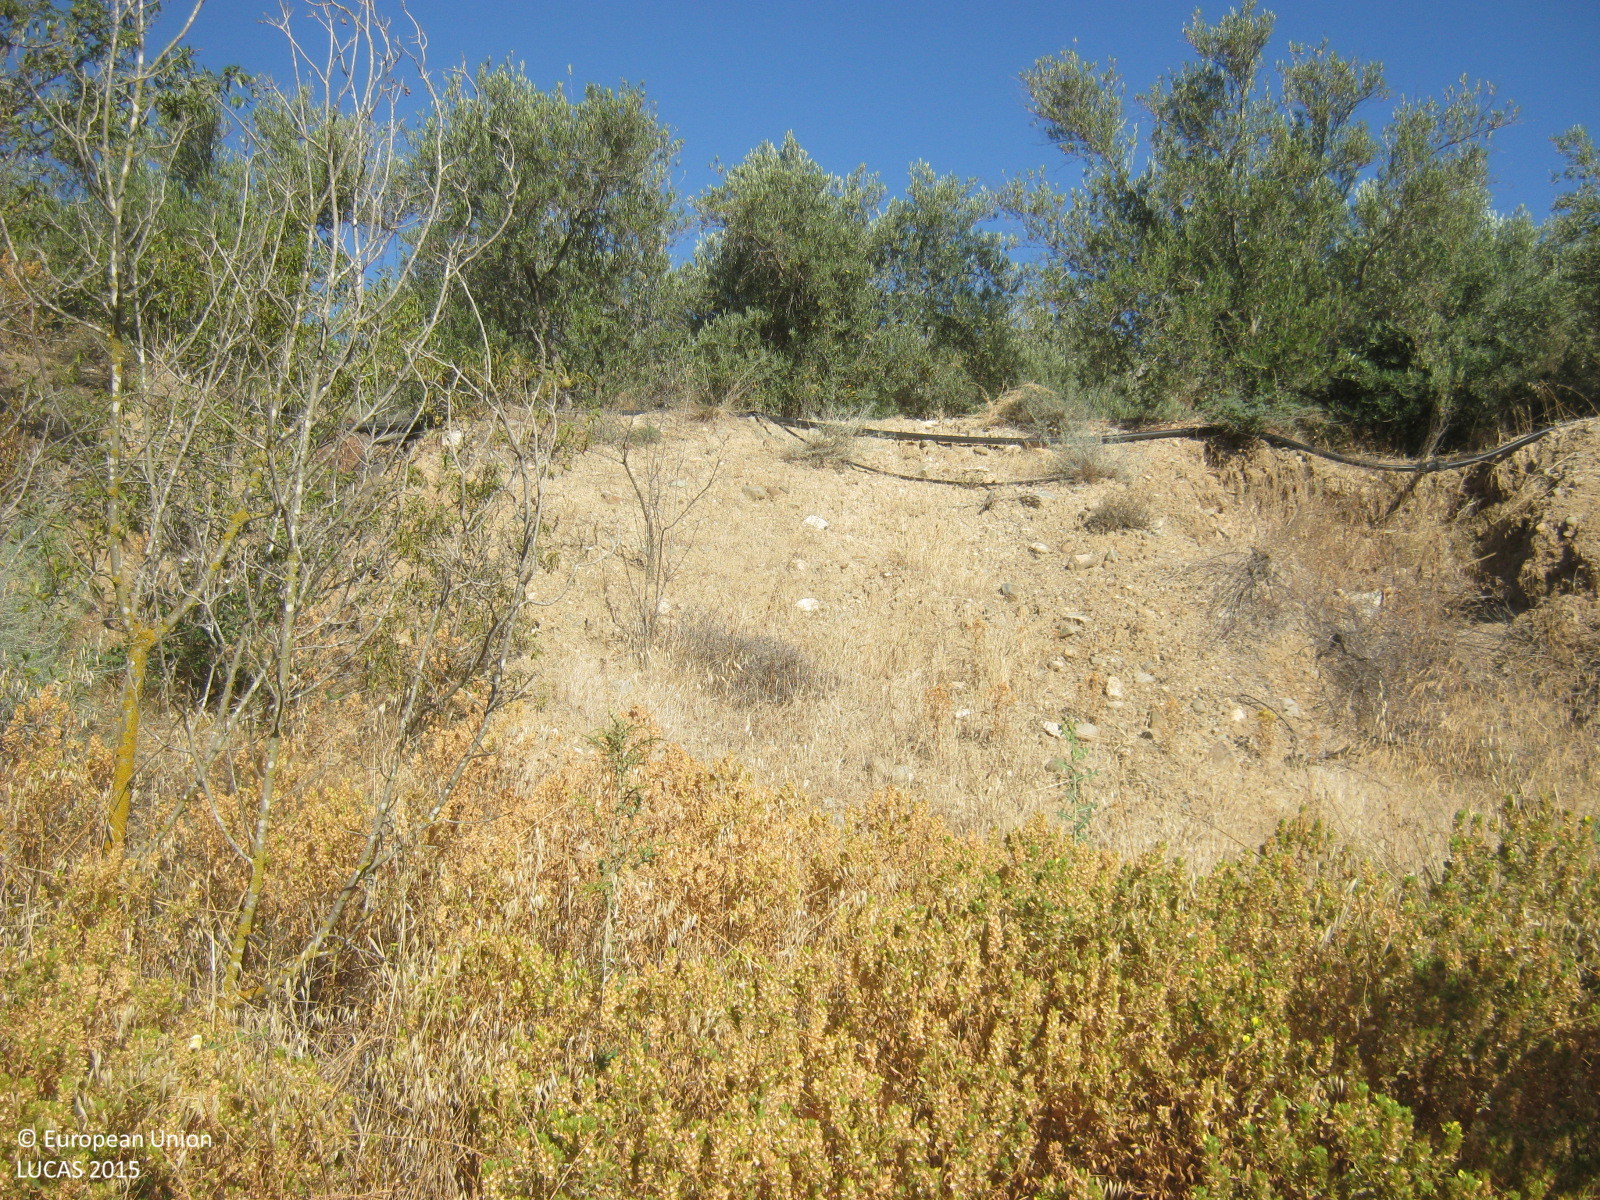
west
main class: Cropland
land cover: Nuts trees
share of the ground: 10 - 25 %
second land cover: Other bare soil
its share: > 75 %
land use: Agriculture (excluding fallow land and kitchen gardens)
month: June
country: CY
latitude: 35.1017
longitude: 33.1896
